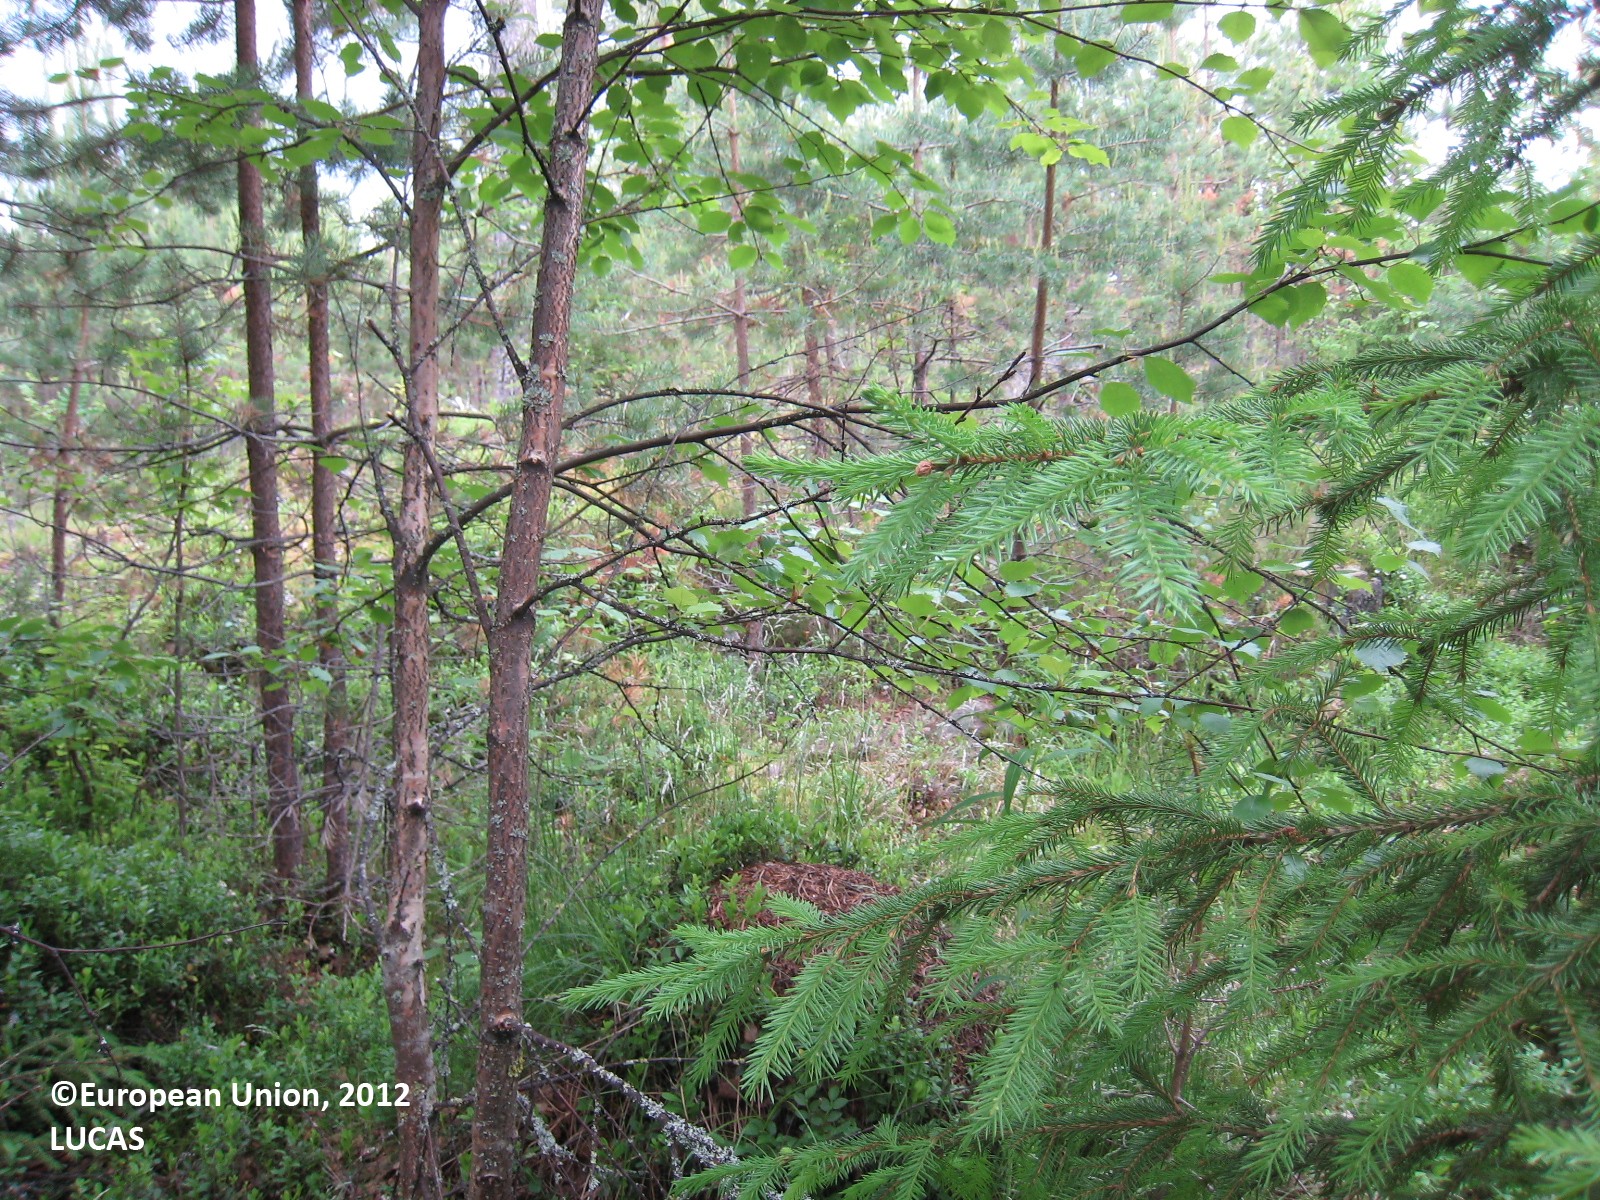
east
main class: Woodland
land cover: Other mixed woodland
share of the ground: > 75 %
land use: Forestry
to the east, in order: Other mixed woodland; Pine dominated coniferous woodland; Other mixed woodland; Ditches and canals; Pine dominated coniferous woodland; Pine dominated mixed woodland; Other mixed woodland; Pine dominated mixed woodland; Ditches and canals; Pine dominated coniferous woodland; Ditches and canals; Pine dominated coniferous woodland; Ditches and canals; Pine dominated coniferous woodland; Ditches and canals; Pine dominated coniferous woodland
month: June
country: FI
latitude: 62.1044
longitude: 26.2870
